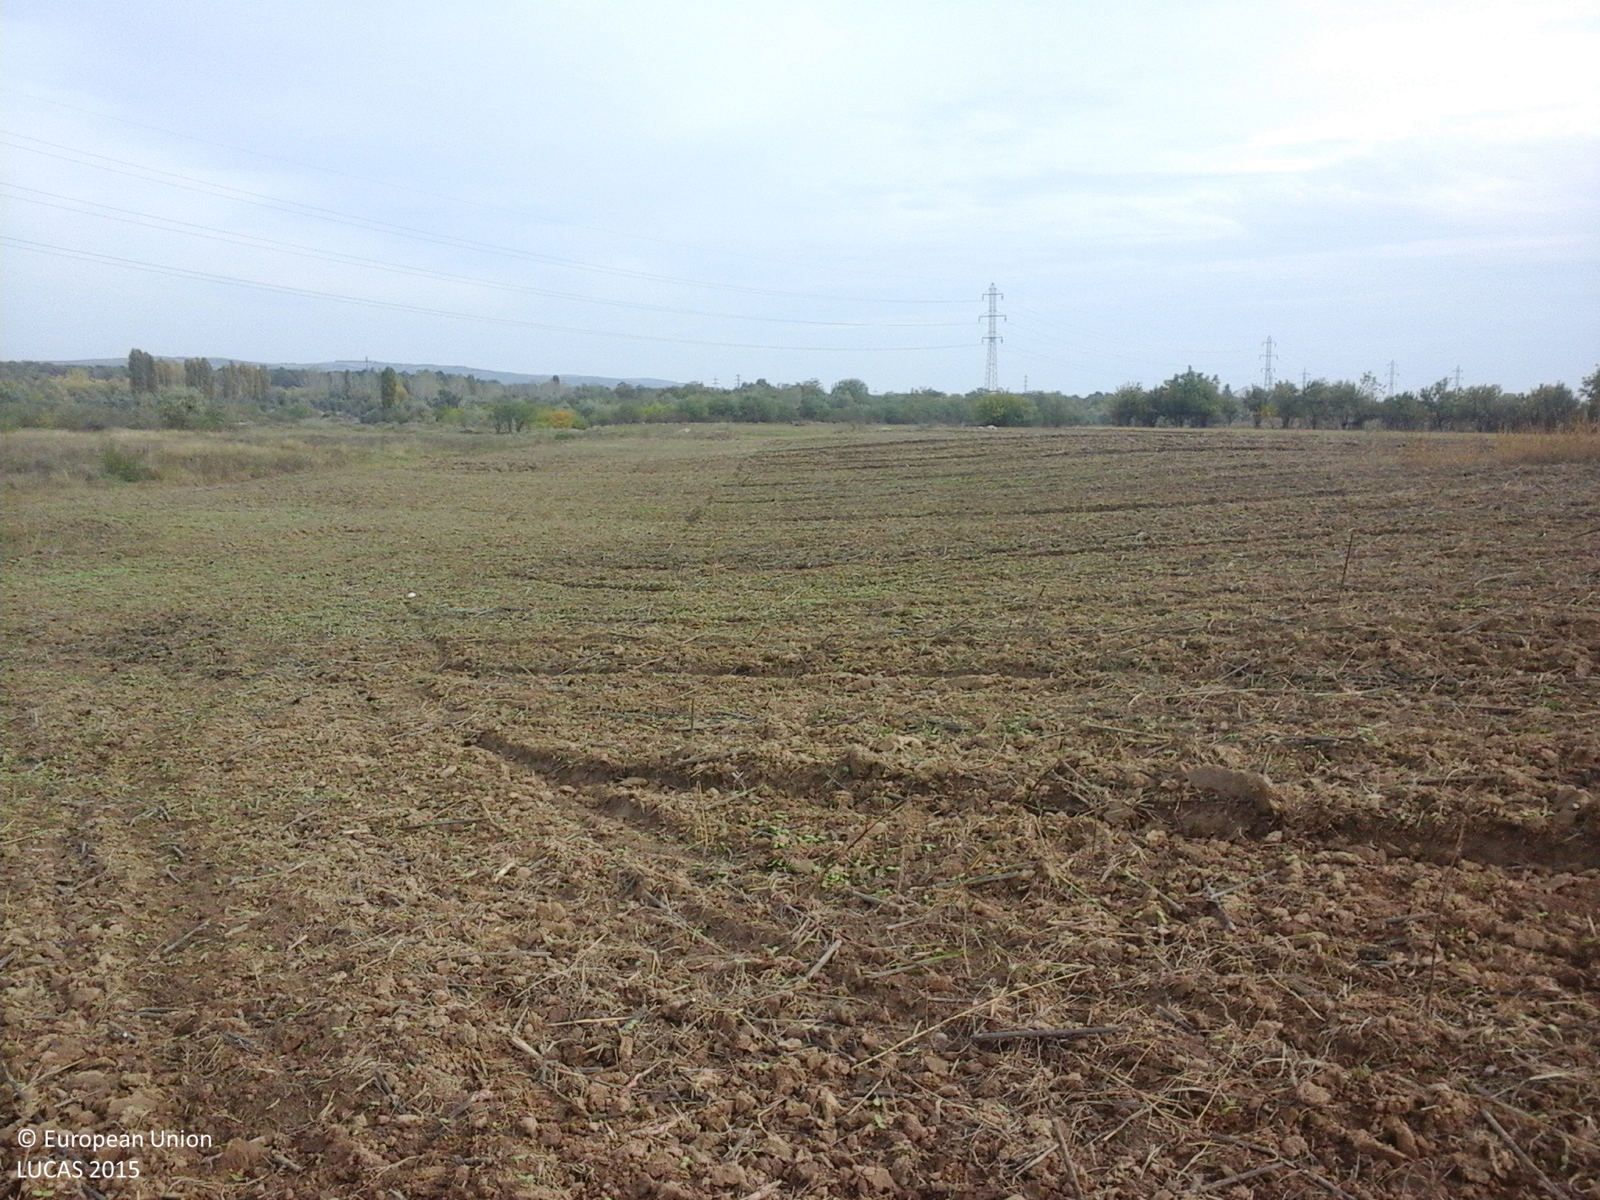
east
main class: Cropland
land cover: Sunflower
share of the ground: 10 - 25 %
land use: Agriculture (excluding fallow land and kitchen gardens)
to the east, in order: Sunflower; Grassland without tree/shrub cover; Electric lines; Grassland without tree/shrub cover; Spontaneously vegetated surfaces; Tracks
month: October
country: RO
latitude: 44.9647
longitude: 26.0453
